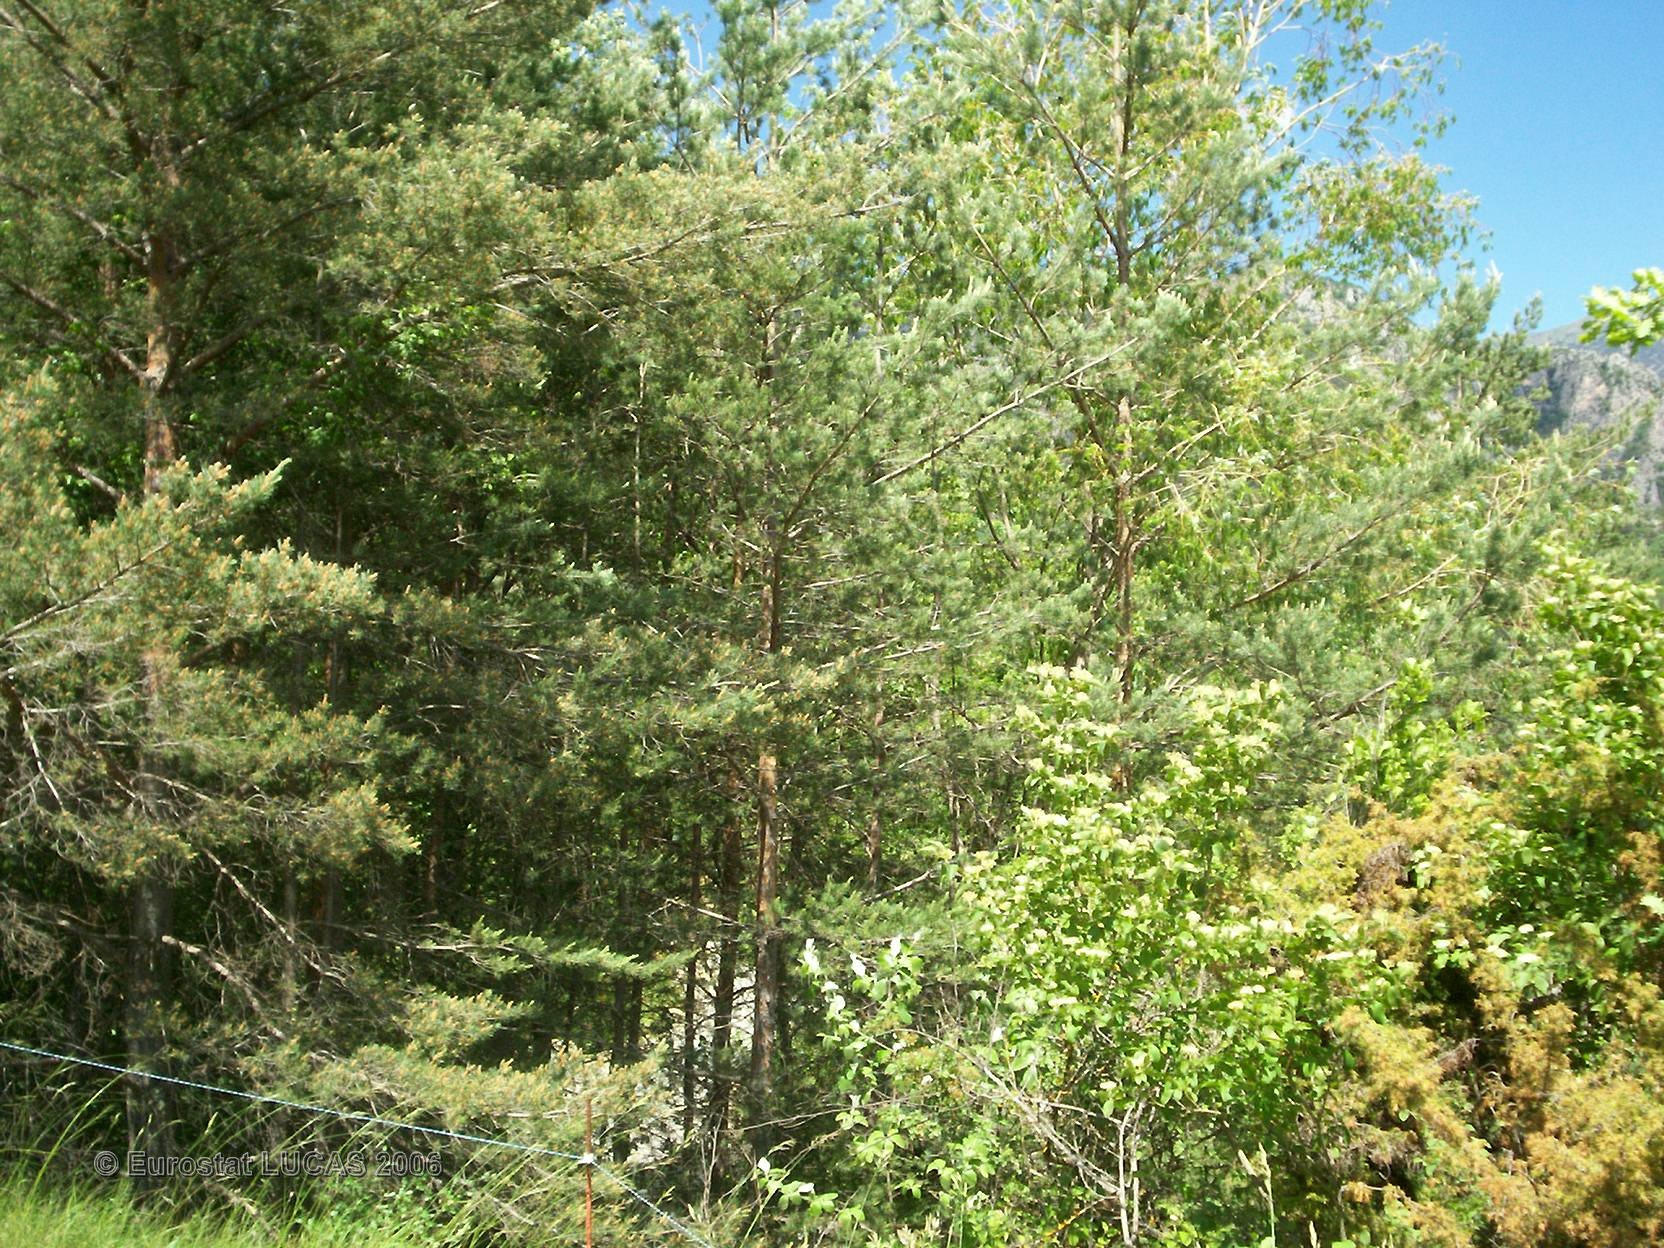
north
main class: Grassland
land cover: Grassland with sparse tree/shrub cover
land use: Agriculture (excluding fallow land and kitchen gardens)
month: May
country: FR
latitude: 44.0086
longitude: 7.2996
